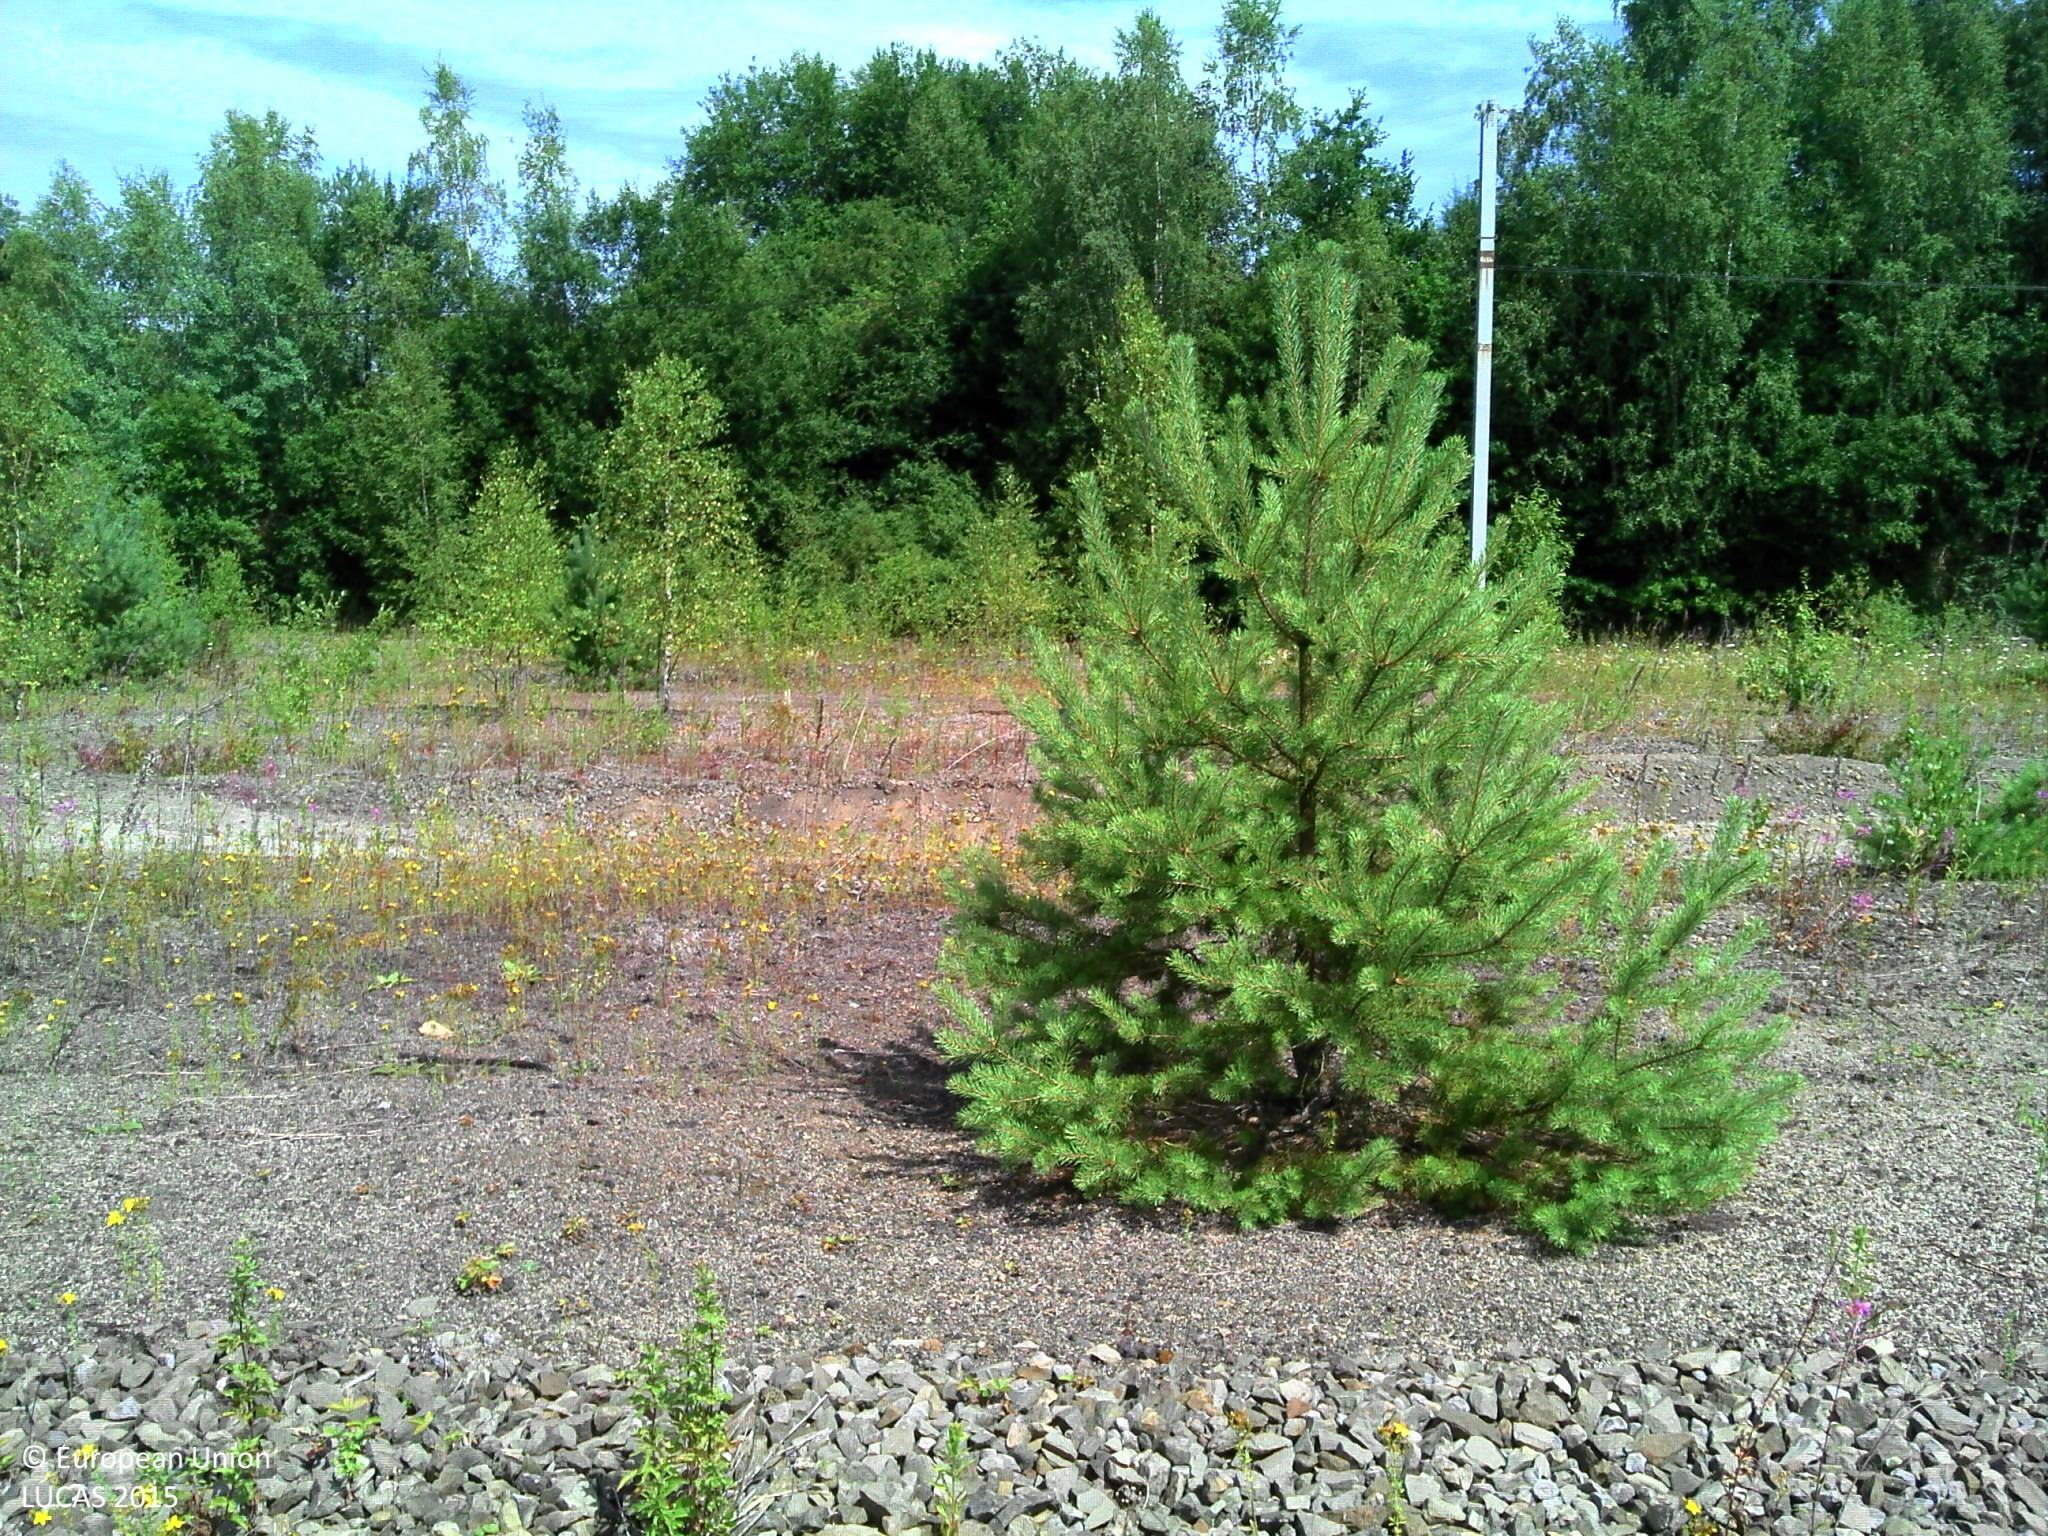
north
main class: Grassland
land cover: Spontaneously vegetated surfaces
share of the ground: 50 - 75 %
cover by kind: herbaceous plants 55 %, unconsolidated bare surface 40 %, shrubs 5 %
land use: Semi-natural and natural areas not in use
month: July
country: BE
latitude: 49.6906
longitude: 5.7432
